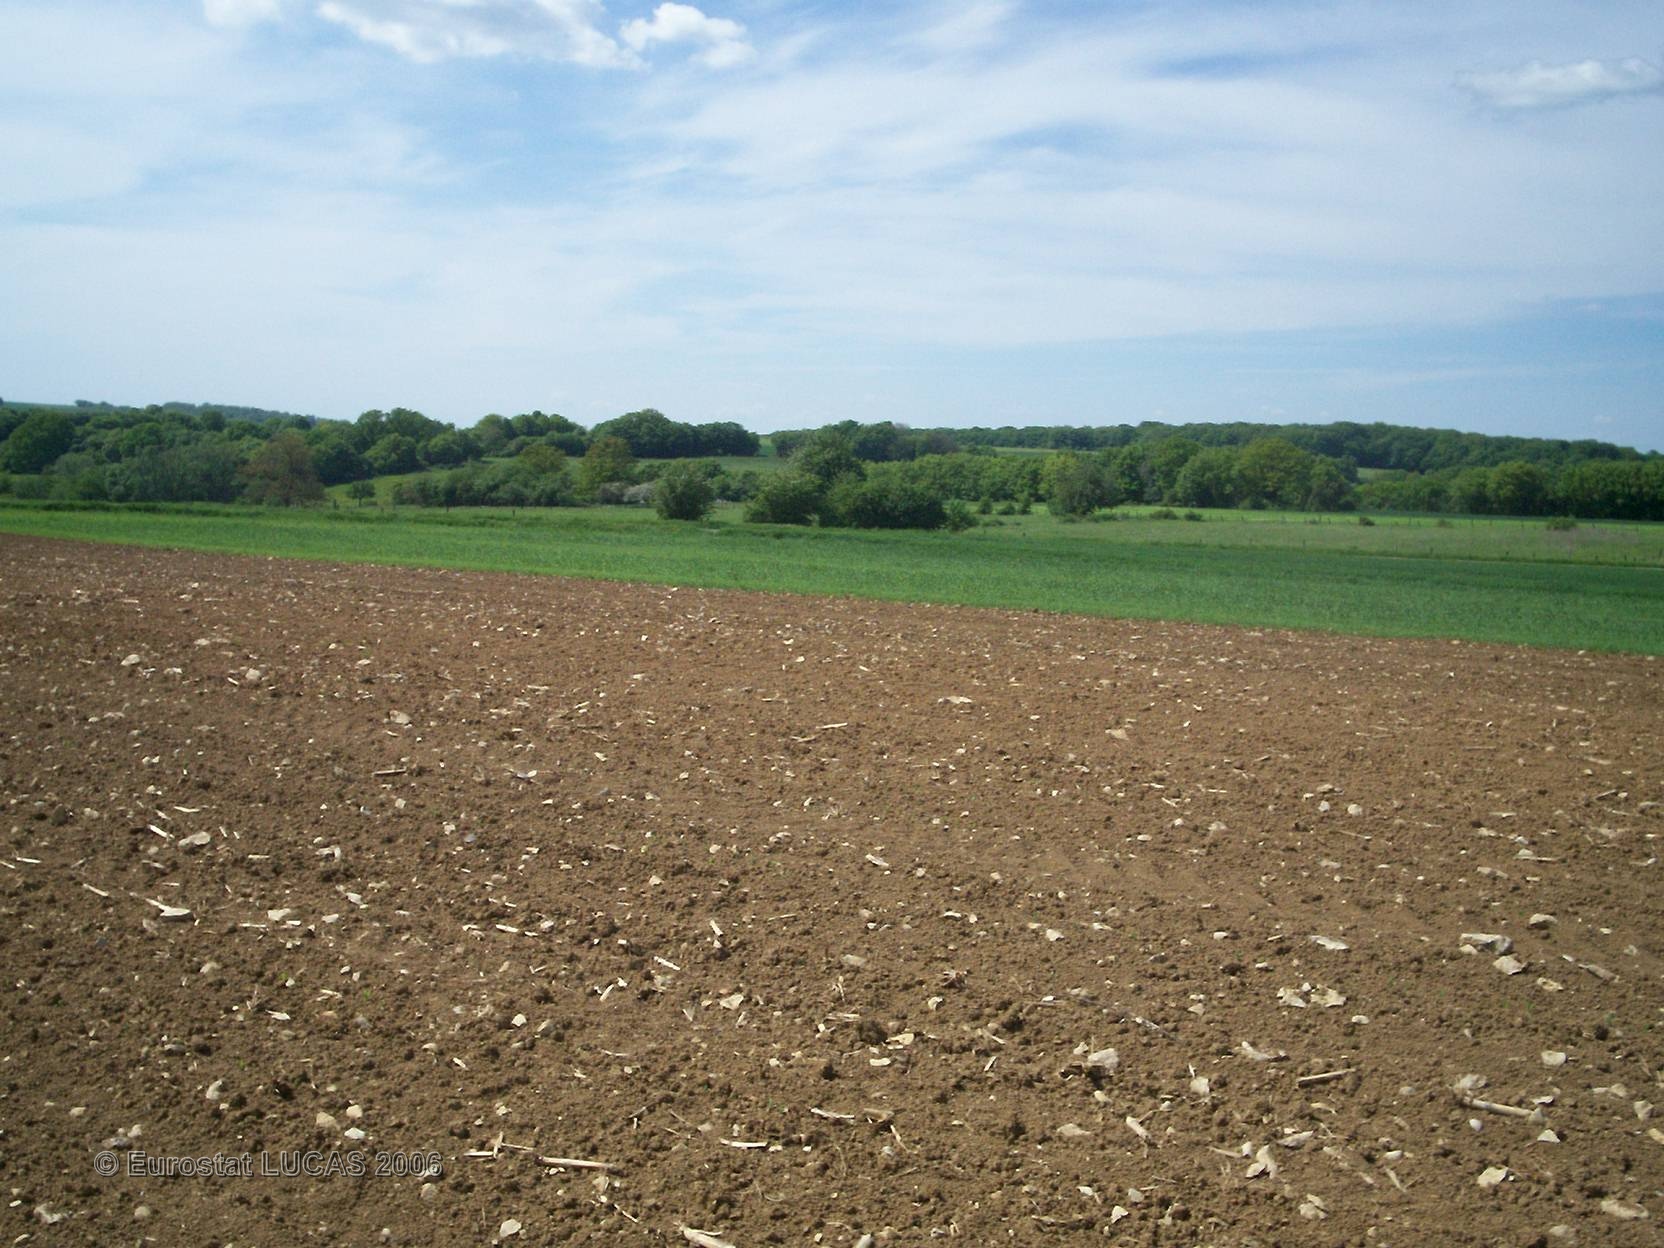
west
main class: Cropland
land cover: Maize
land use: Agriculture (excluding fallow land and kitchen gardens)
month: May
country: FR
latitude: 48.7789
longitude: 7.0747
